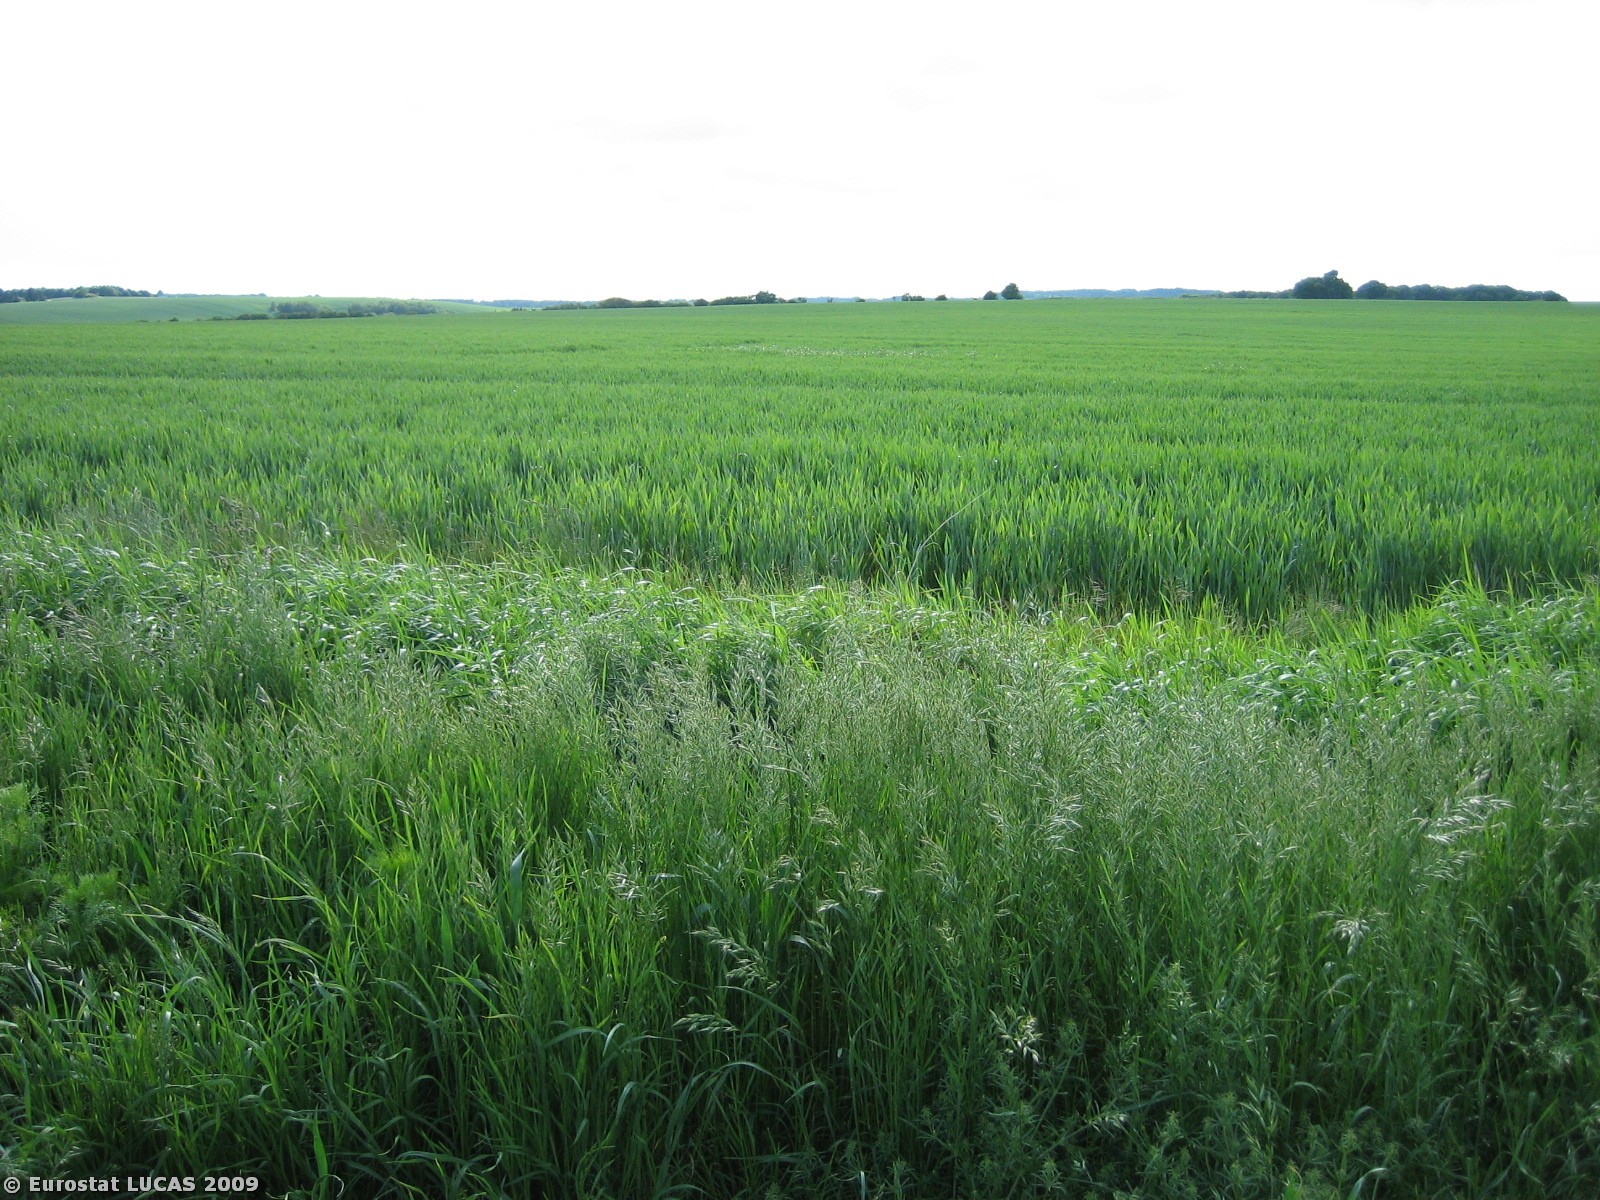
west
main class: Cropland
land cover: Common wheat
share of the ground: > 75 %
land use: Agriculture (excluding fallow land and kitchen gardens)
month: June
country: DK
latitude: 56.2235
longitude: 9.7906
